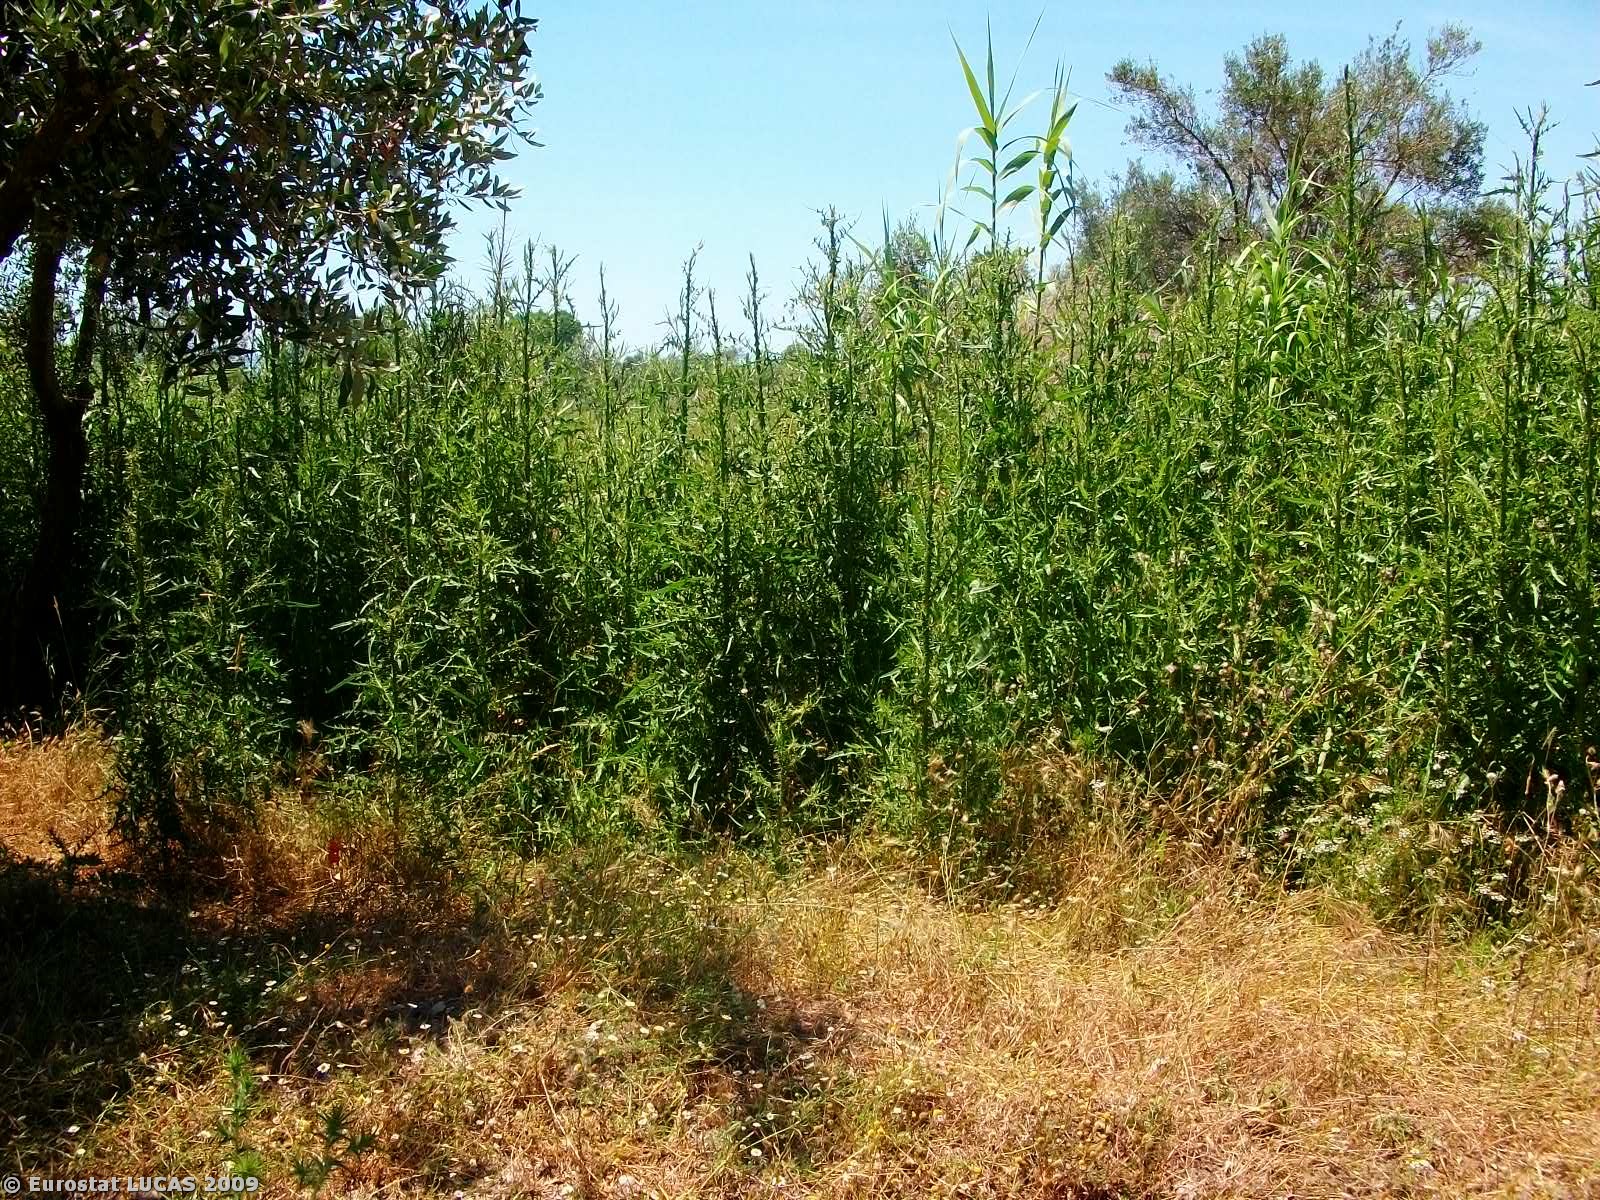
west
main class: Cropland
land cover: Olive groves
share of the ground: 50 - 75 %
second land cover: Grassland with sparse tree/shrub cover
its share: > 75 %
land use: Agriculture (excluding fallow land and kitchen gardens)
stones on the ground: < 10 %
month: June
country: GR
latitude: 38.6010
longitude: 21.5102
